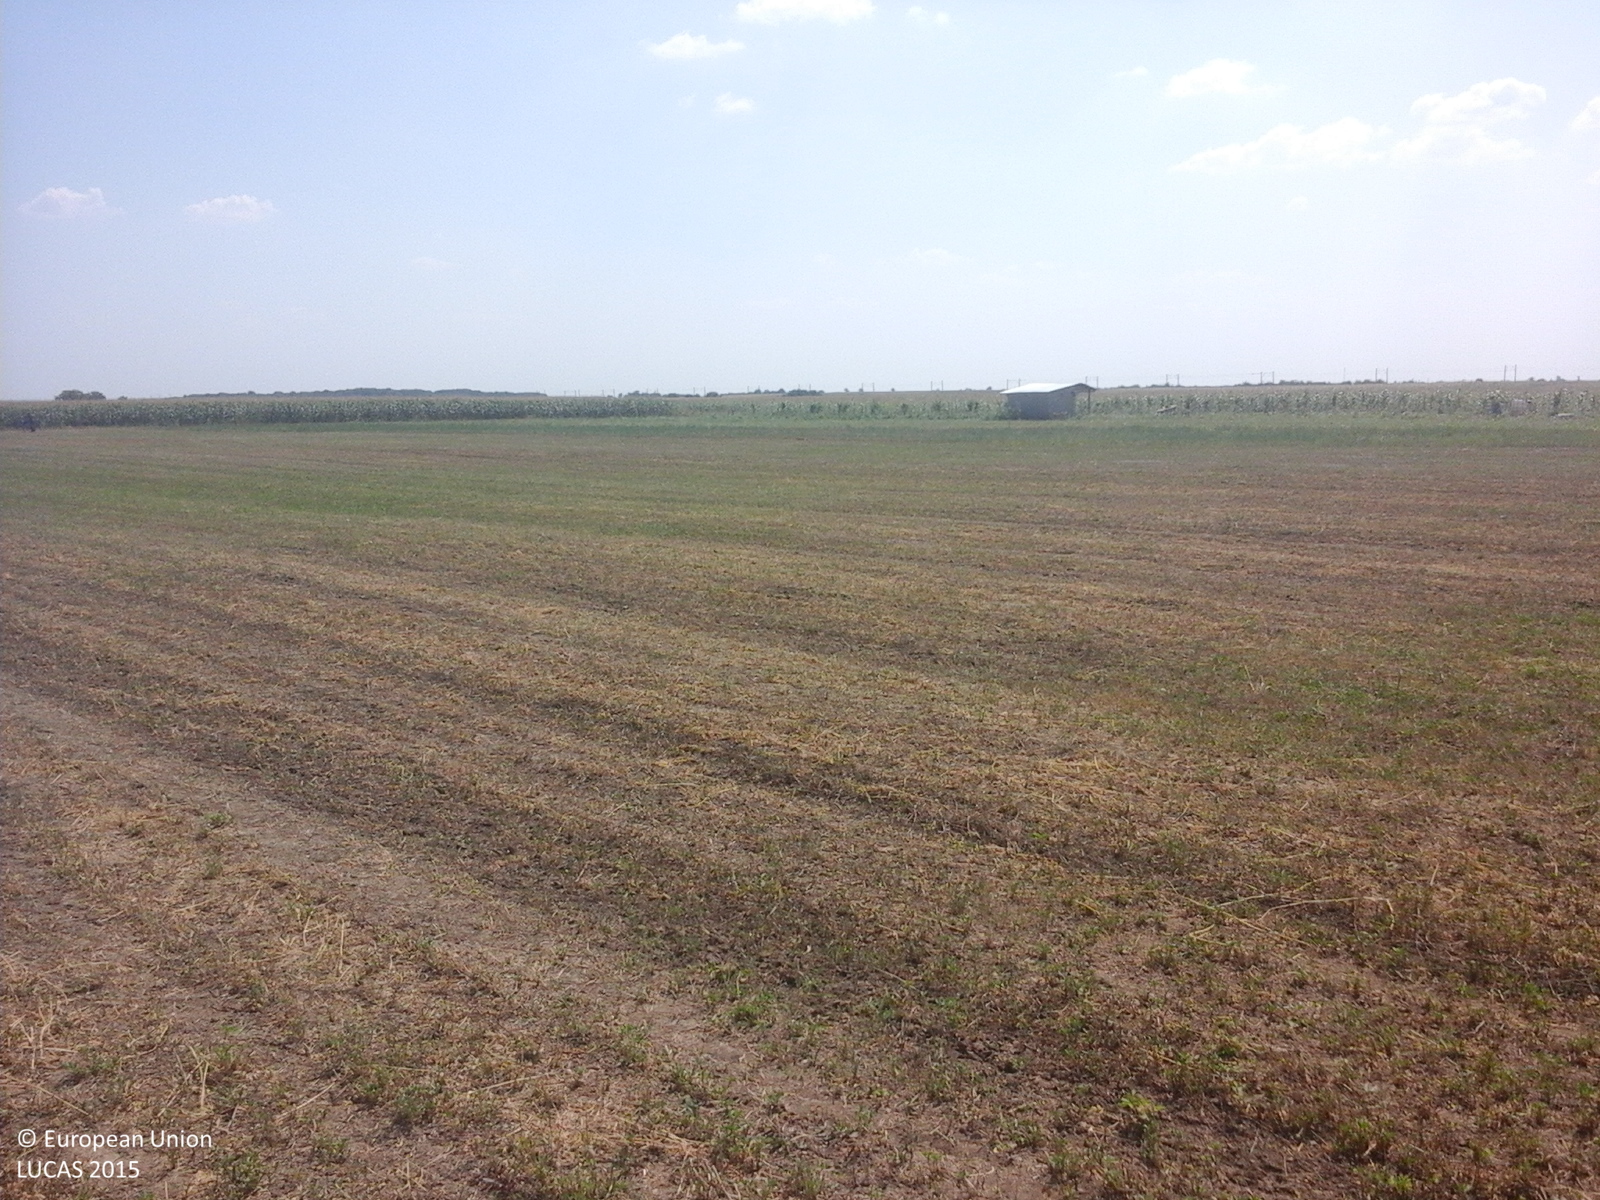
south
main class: Cropland
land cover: Maize
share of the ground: > 75 %
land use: Agriculture (excluding fallow land and kitchen gardens)
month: August
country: RO
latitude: 45.1049
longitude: 26.8956
